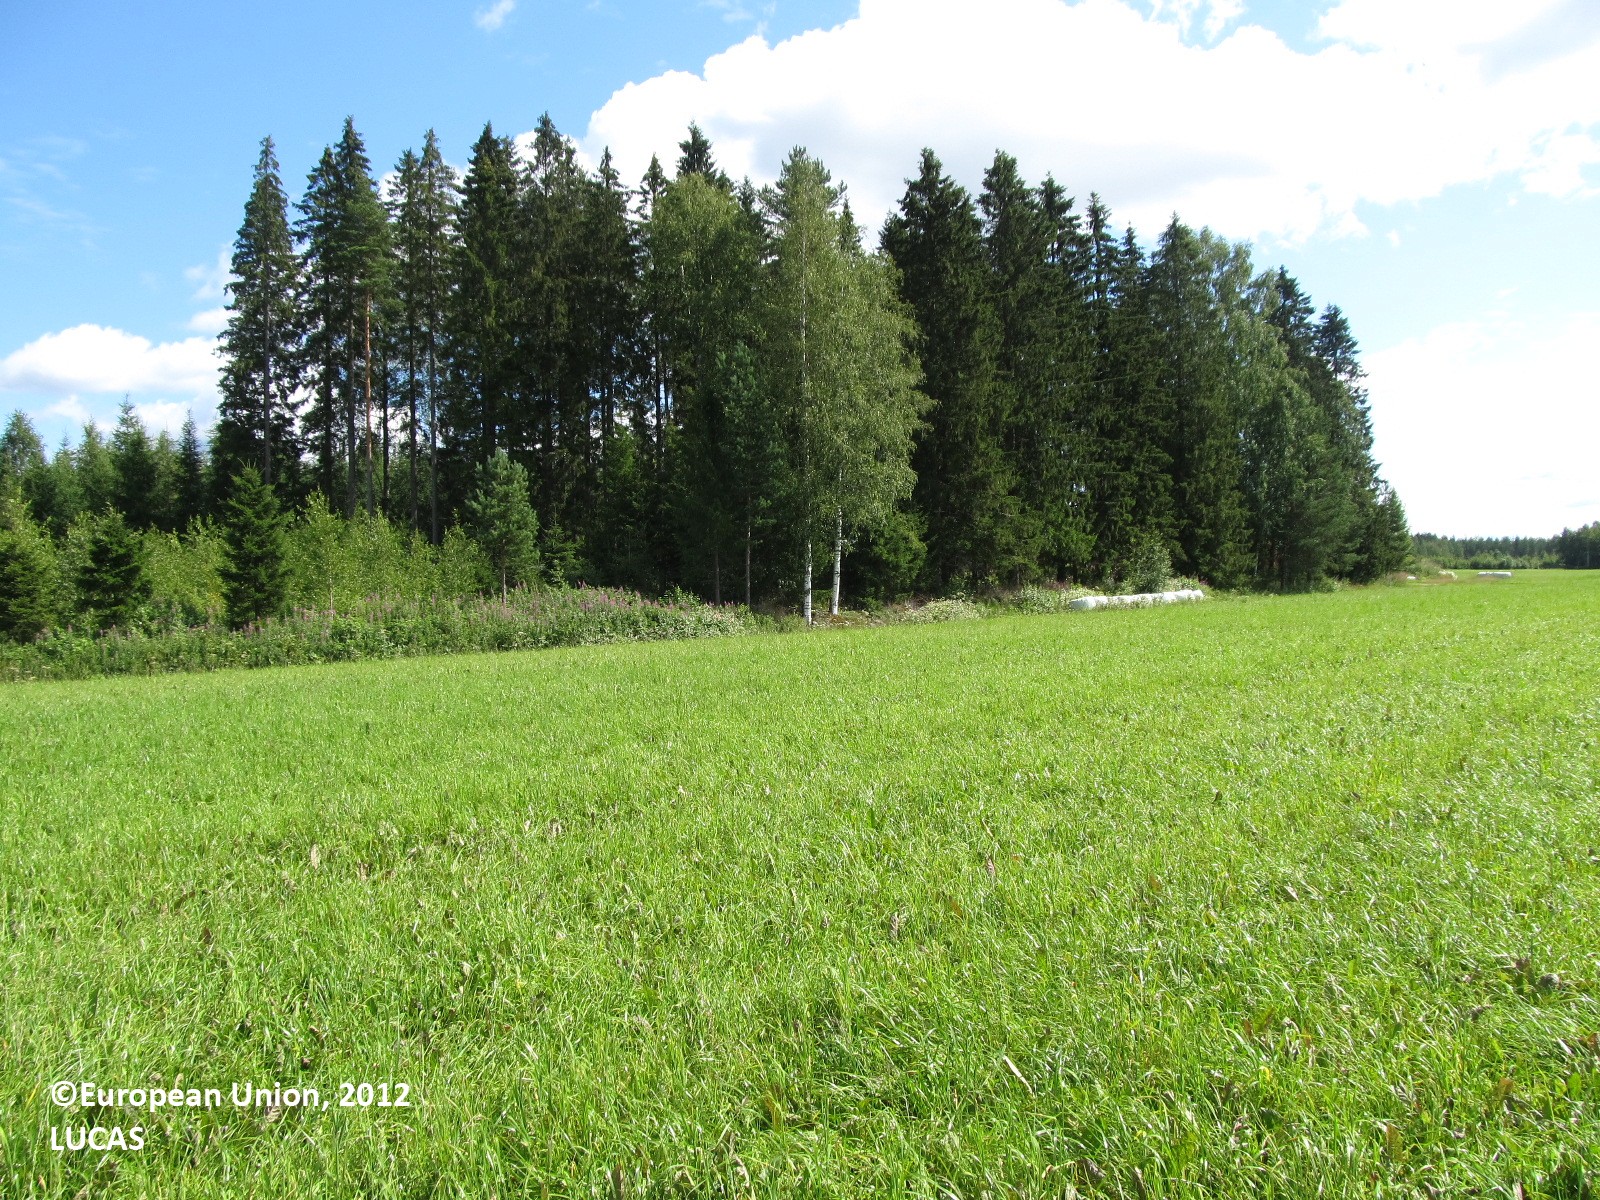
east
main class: Cropland
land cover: Temporary grasslands
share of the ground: 50 - 75 %
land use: Agriculture (excluding fallow land and kitchen gardens)
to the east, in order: Temporary grasslands; Ditches and canals; Spruce dominated mixed woodland; Broadleaved woodland; Tracks; Pine dominated mixed woodland; Lines of trees; Temporary grasslands
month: July
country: FI
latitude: 62.0567
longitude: 27.9583
